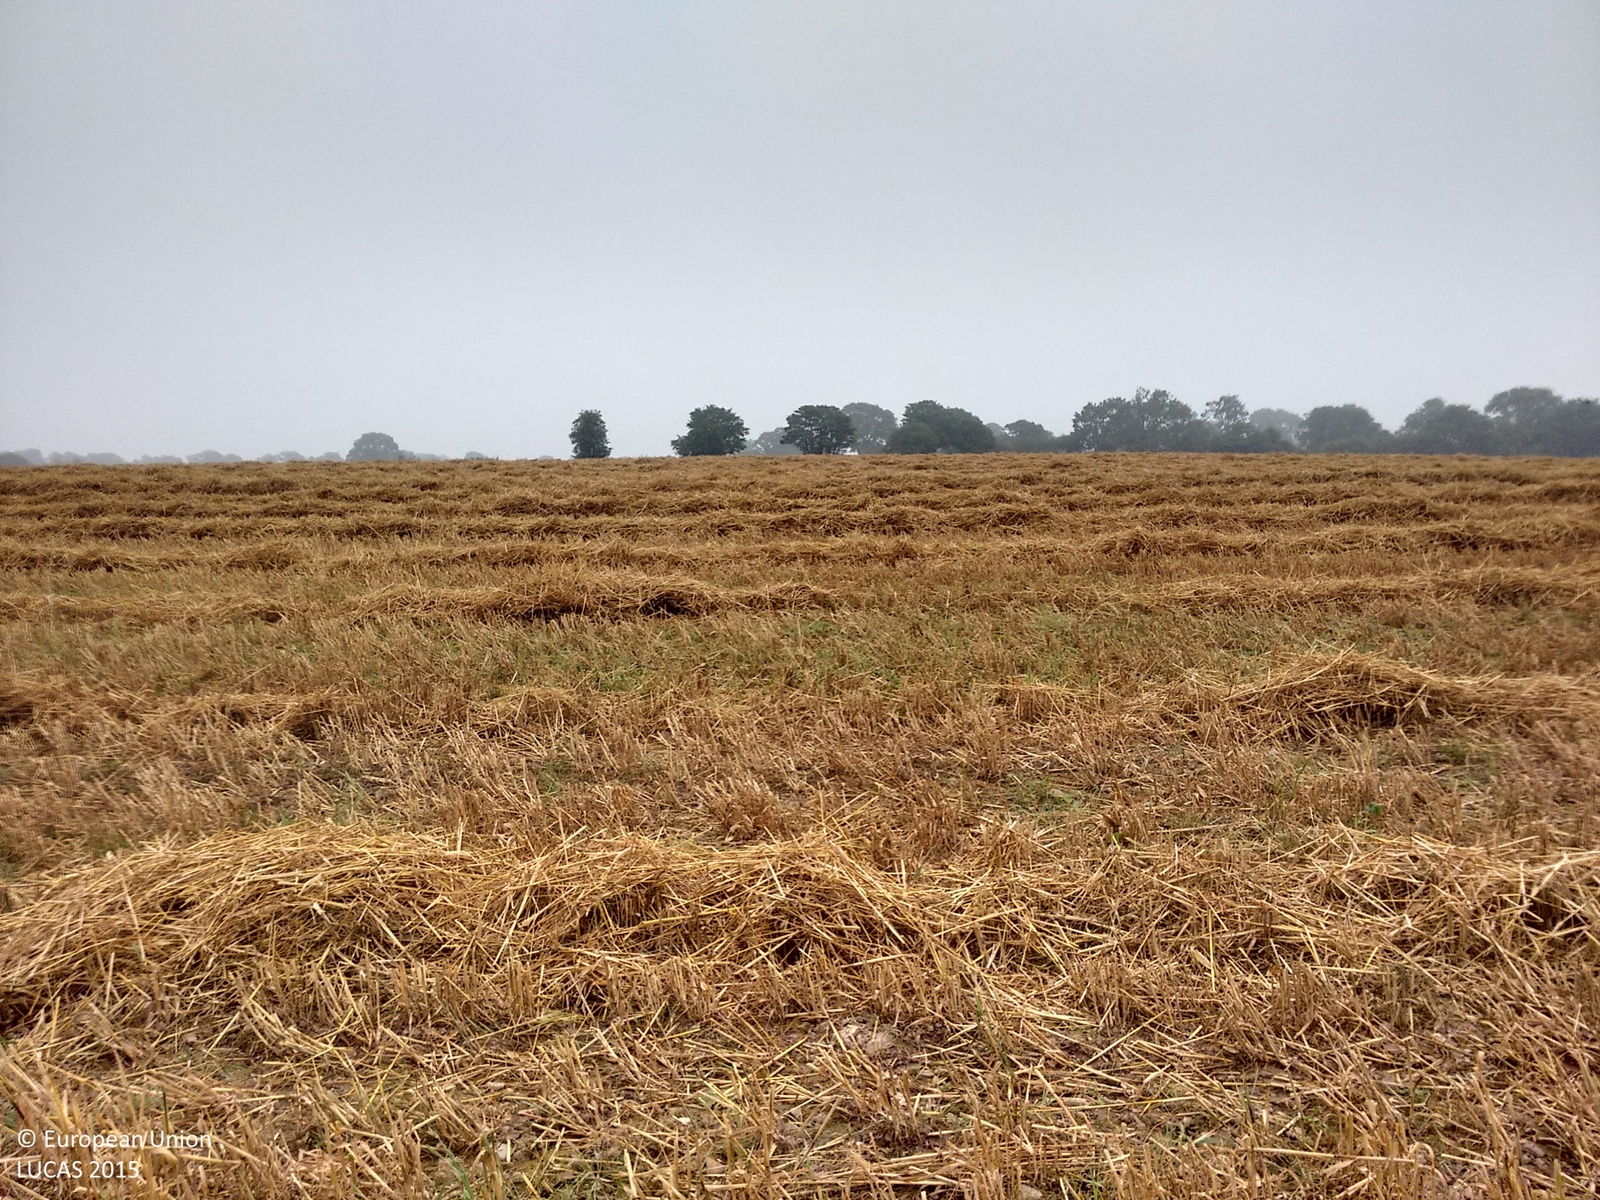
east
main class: Cropland
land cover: Maize
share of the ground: > 75 %
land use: Agriculture (excluding fallow land and kitchen gardens)
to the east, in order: Maize; Grass margins; Managed hedges; Grass margins; Oats; Common wheat
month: September
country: GB
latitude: 52.6610
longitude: -2.8313
